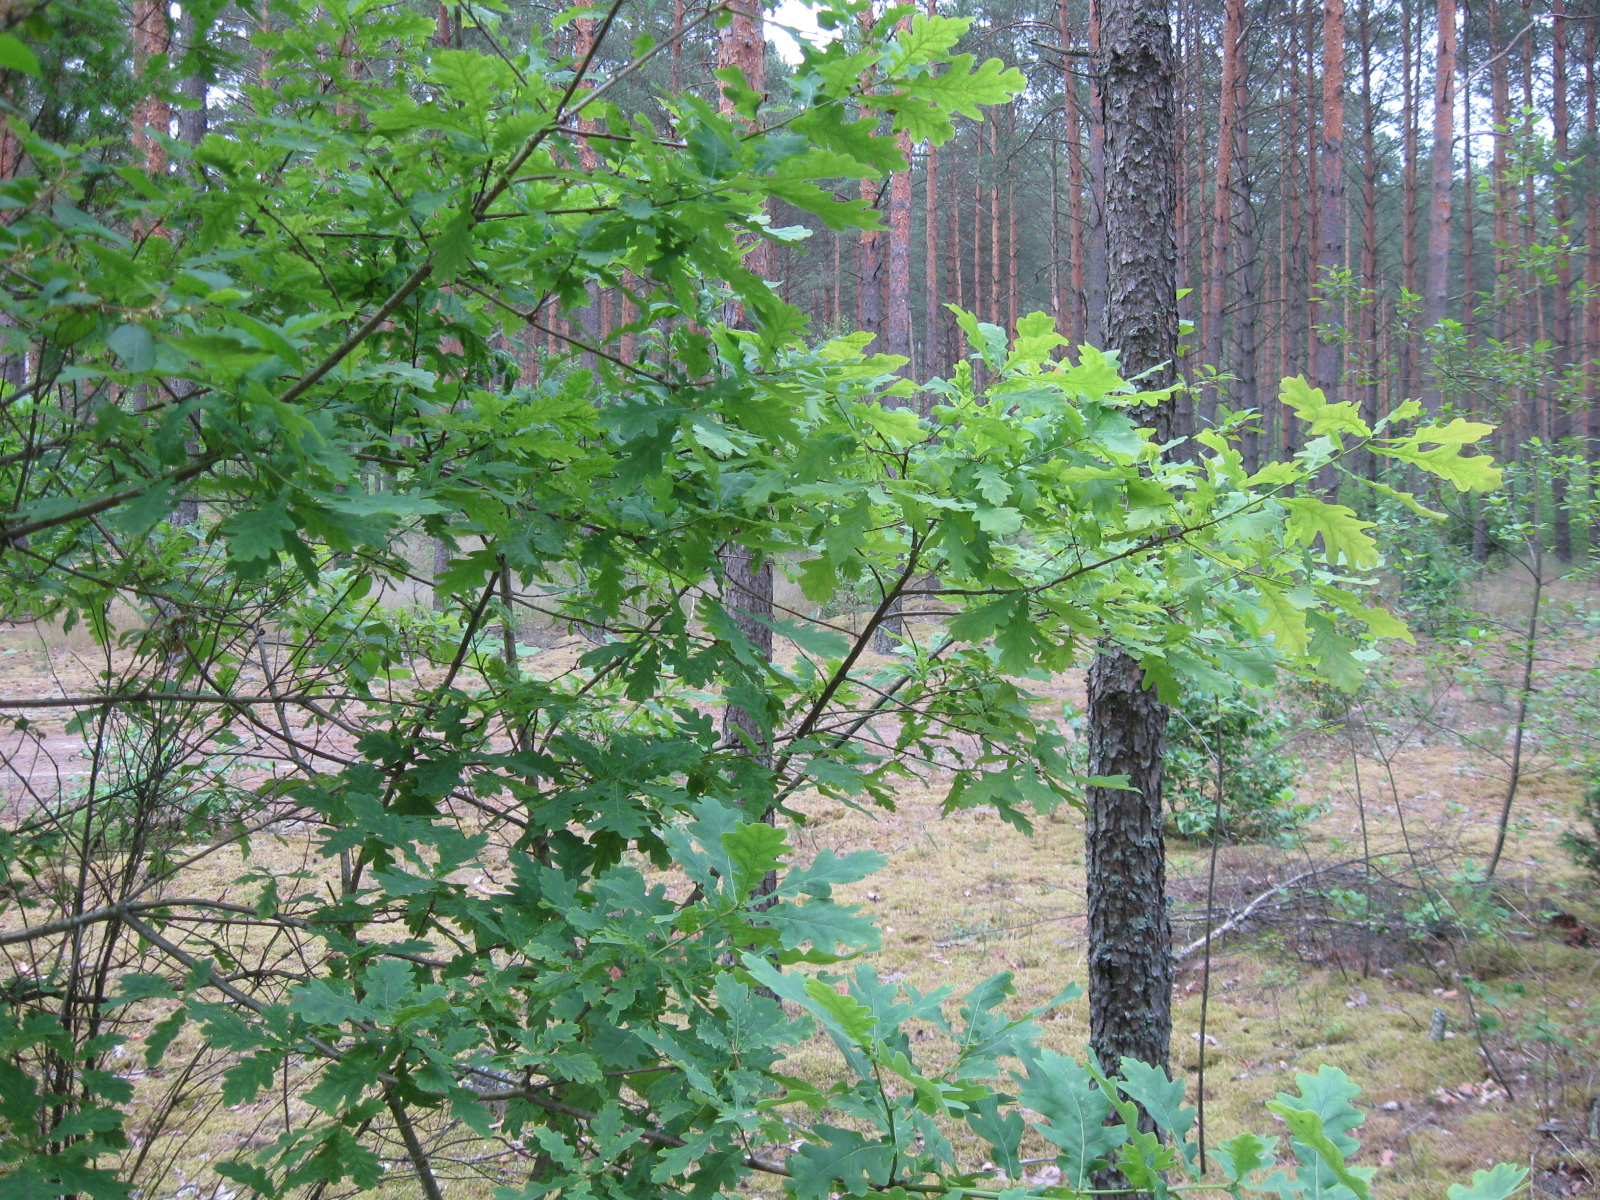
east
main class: Woodland
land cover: Pine dominated mixed woodland
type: hemiboreal forest and nemoral coniferous forest and mixed broadleaved-coniferous forest
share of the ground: > 75 %
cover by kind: coniferous forest trees 50 %, broadleaved forest trees 30 %, lichens and mosses 20 %
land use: Forestry
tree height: > 5 m
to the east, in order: Pine dominated mixed woodland; Electric lines; Tracks; Pine dominated mixed woodland; Pine dominated coniferous woodland; Pine dominated mixed woodland; Grassland with sparse tree/shrub cover
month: July
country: LT
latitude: 54.1037
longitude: 24.2761
